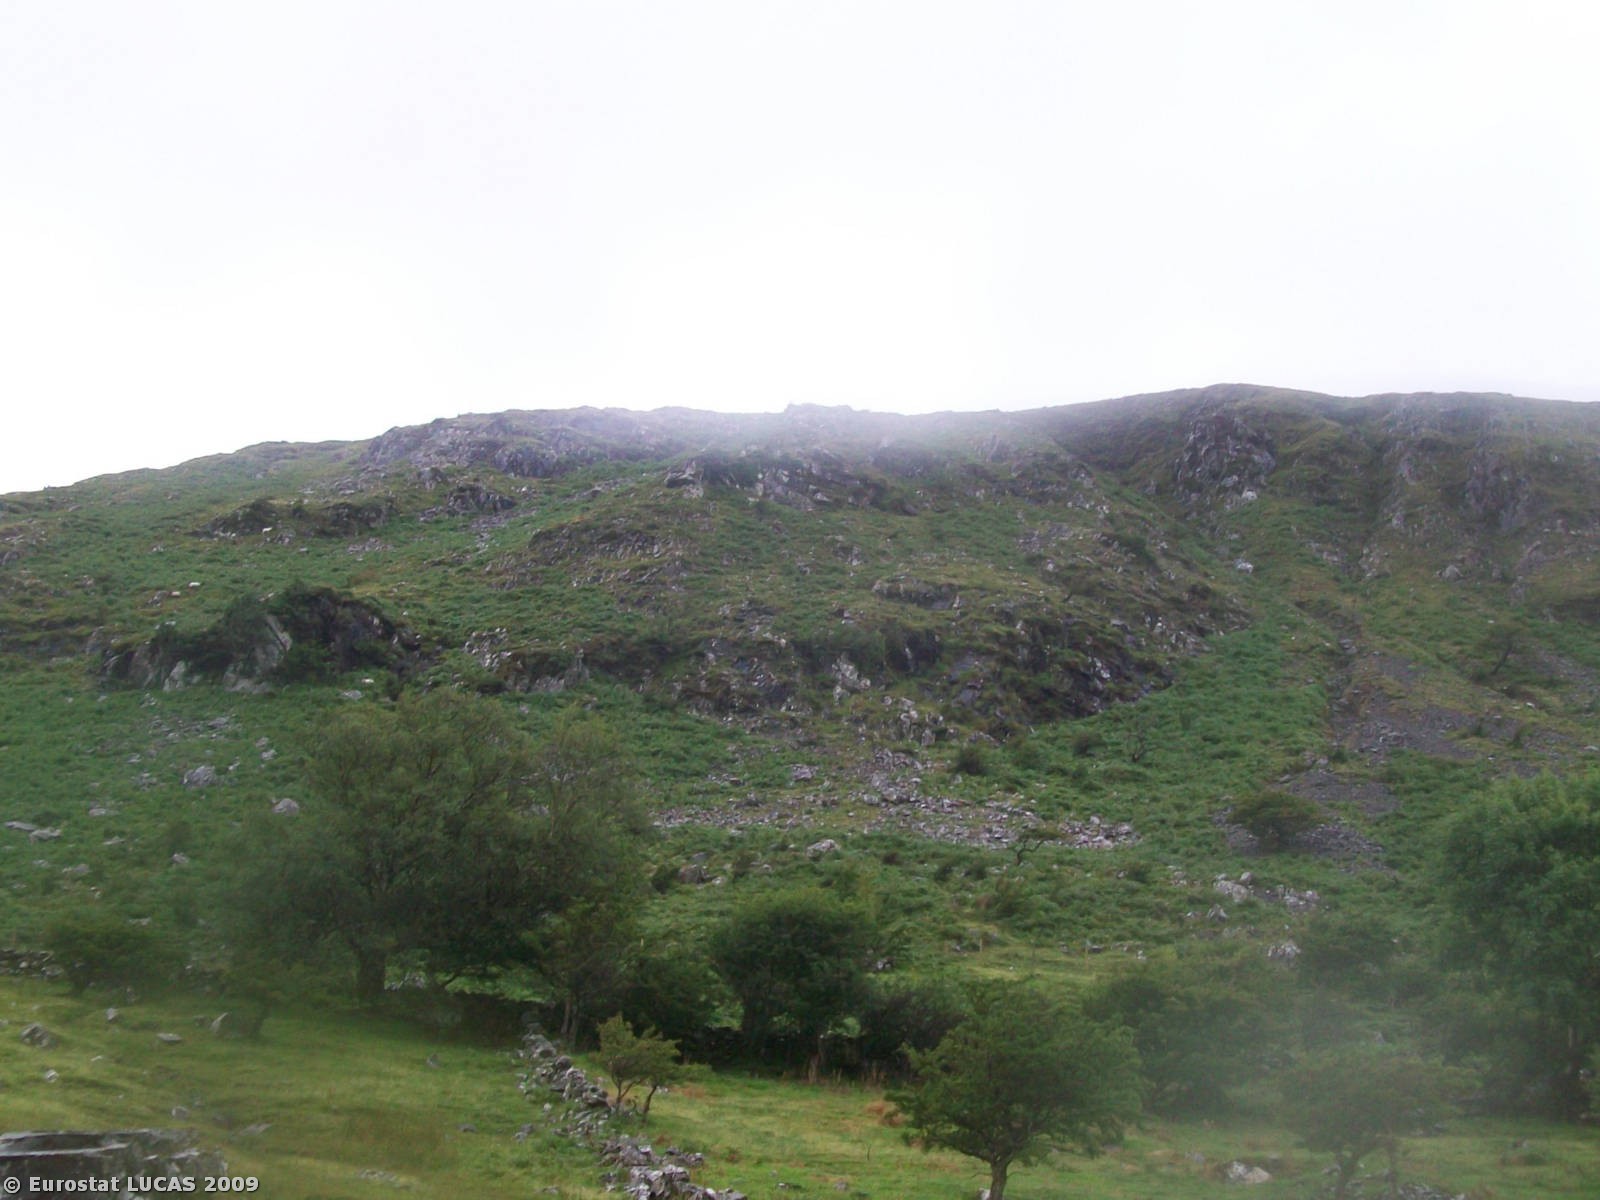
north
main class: Grassland
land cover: Grassland without tree/shrub cover
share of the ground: > 75 %
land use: Agriculture (excluding fallow land and kitchen gardens)
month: July
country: IE
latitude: 53.5433
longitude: -9.5666
